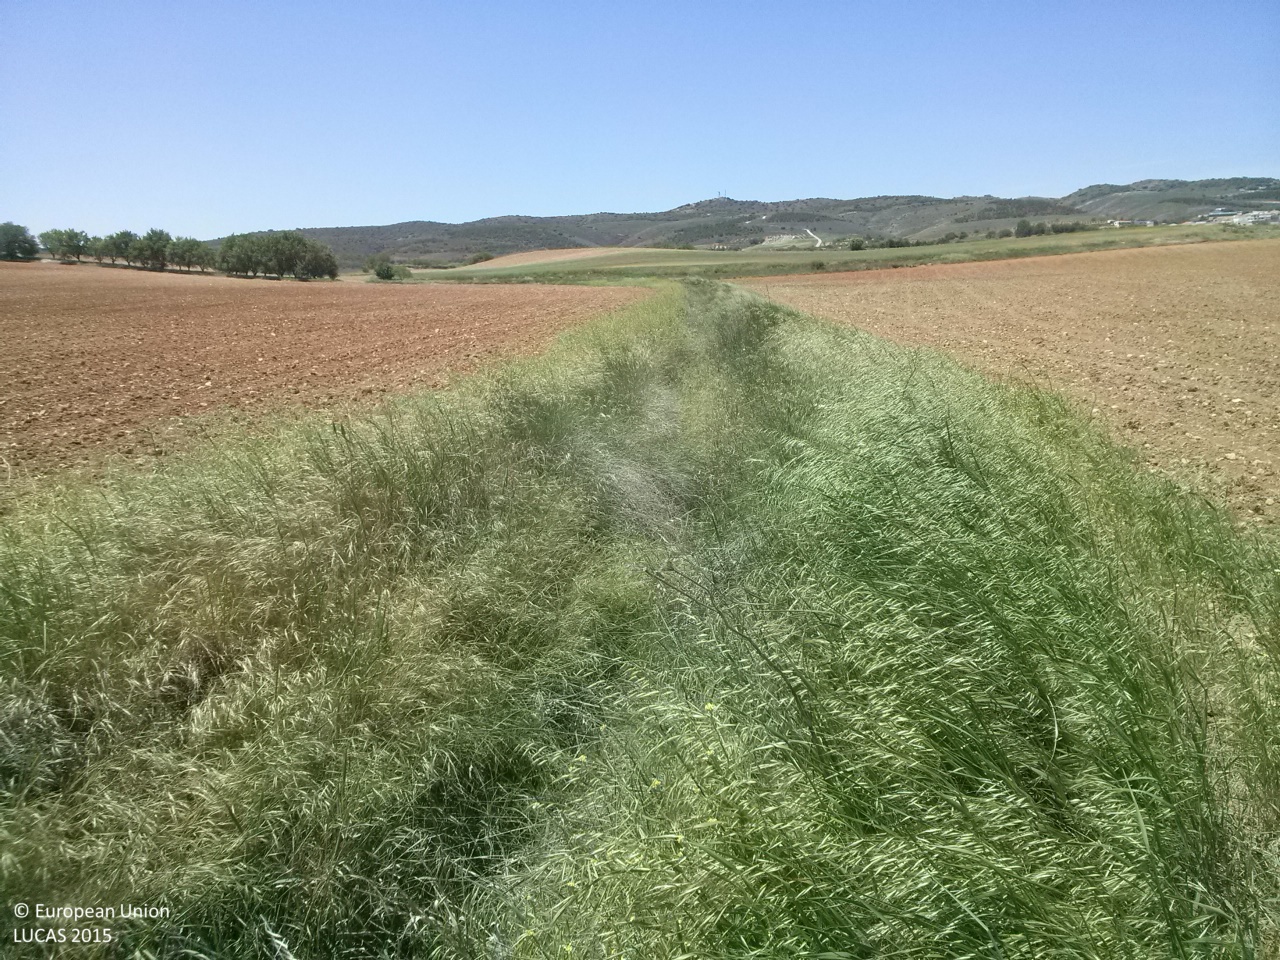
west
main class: Cropland
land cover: Sunflower
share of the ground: < 10 %
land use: Agriculture (excluding fallow land and kitchen gardens)
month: May
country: ES
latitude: 40.1201
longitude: -2.8011
